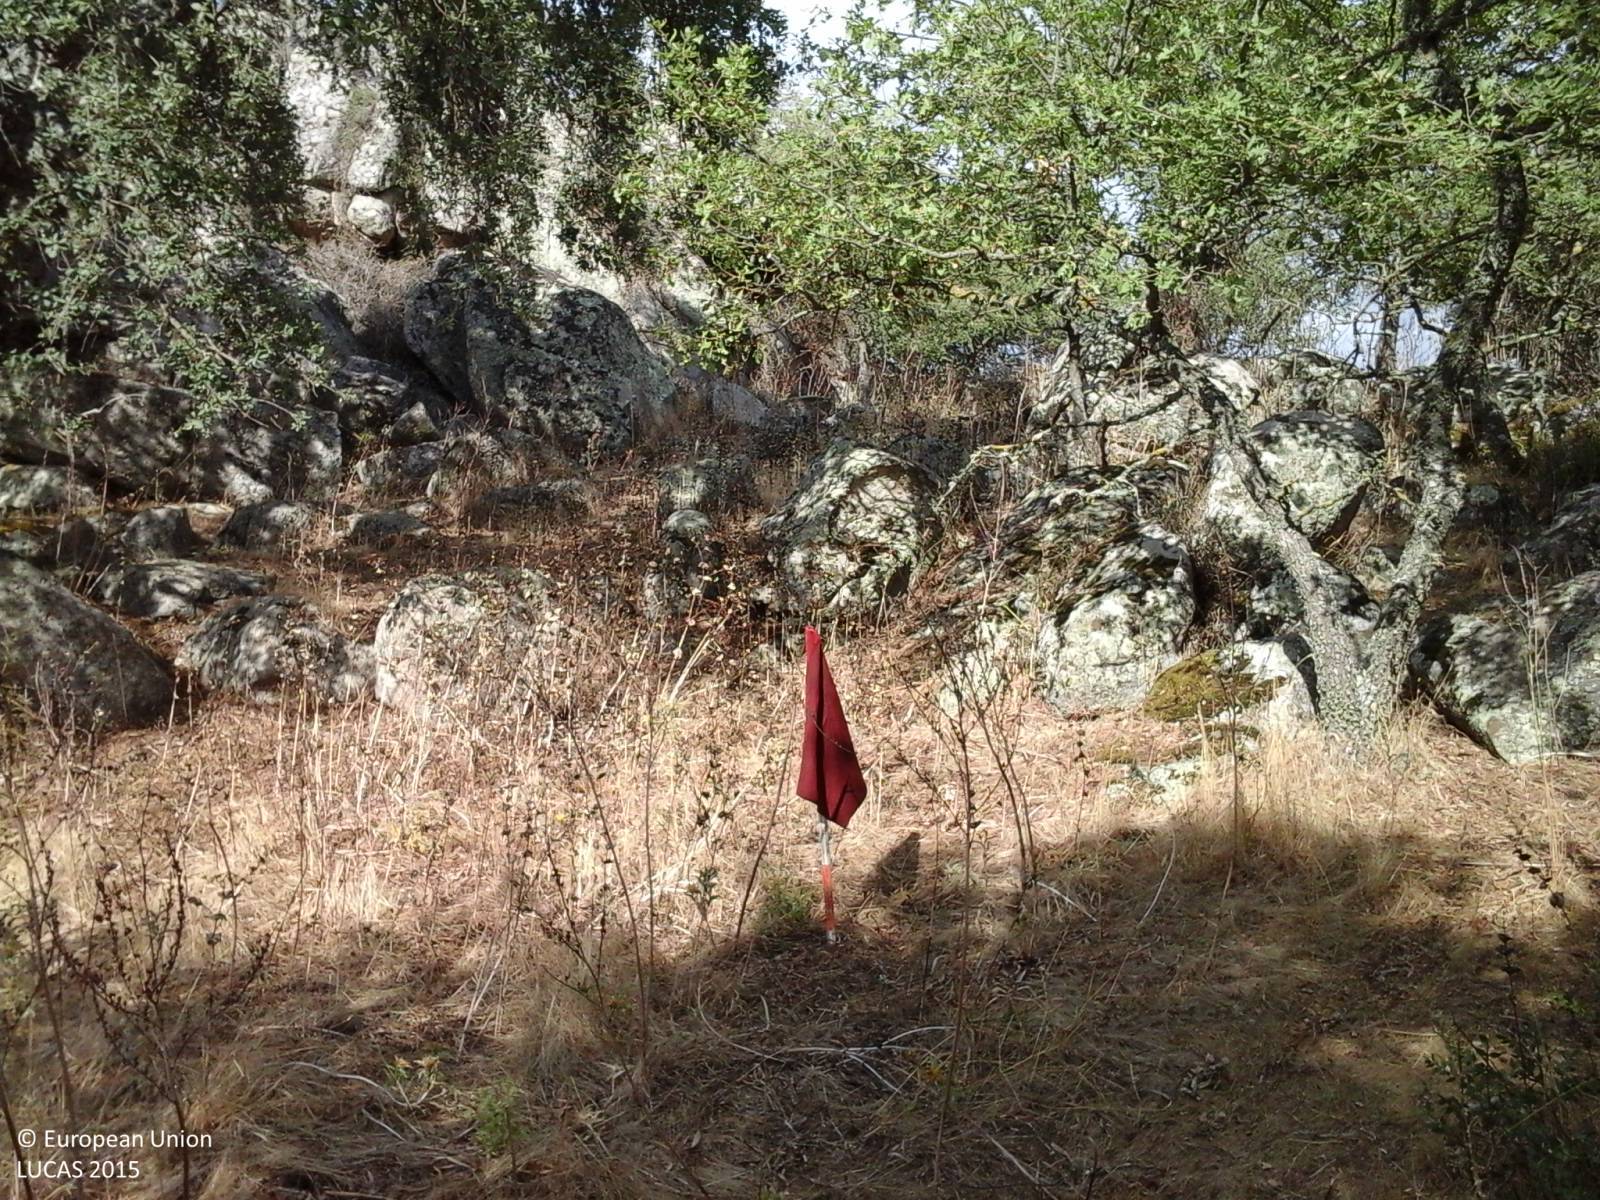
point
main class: Woodland
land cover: Broadleaved woodland
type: broadleaved evergreen forest
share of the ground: > 75 %
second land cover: Grassland without tree/shrub cover
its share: > 75 %
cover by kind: herbaceous plants 55 %, shrubs 35 %, broadleaved forest trees 10 %
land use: Forestry
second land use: Agriculture (excluding fallow land and kitchen gardens)
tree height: > 5 m
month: August
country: IT
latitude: 40.5353
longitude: 9.1660
